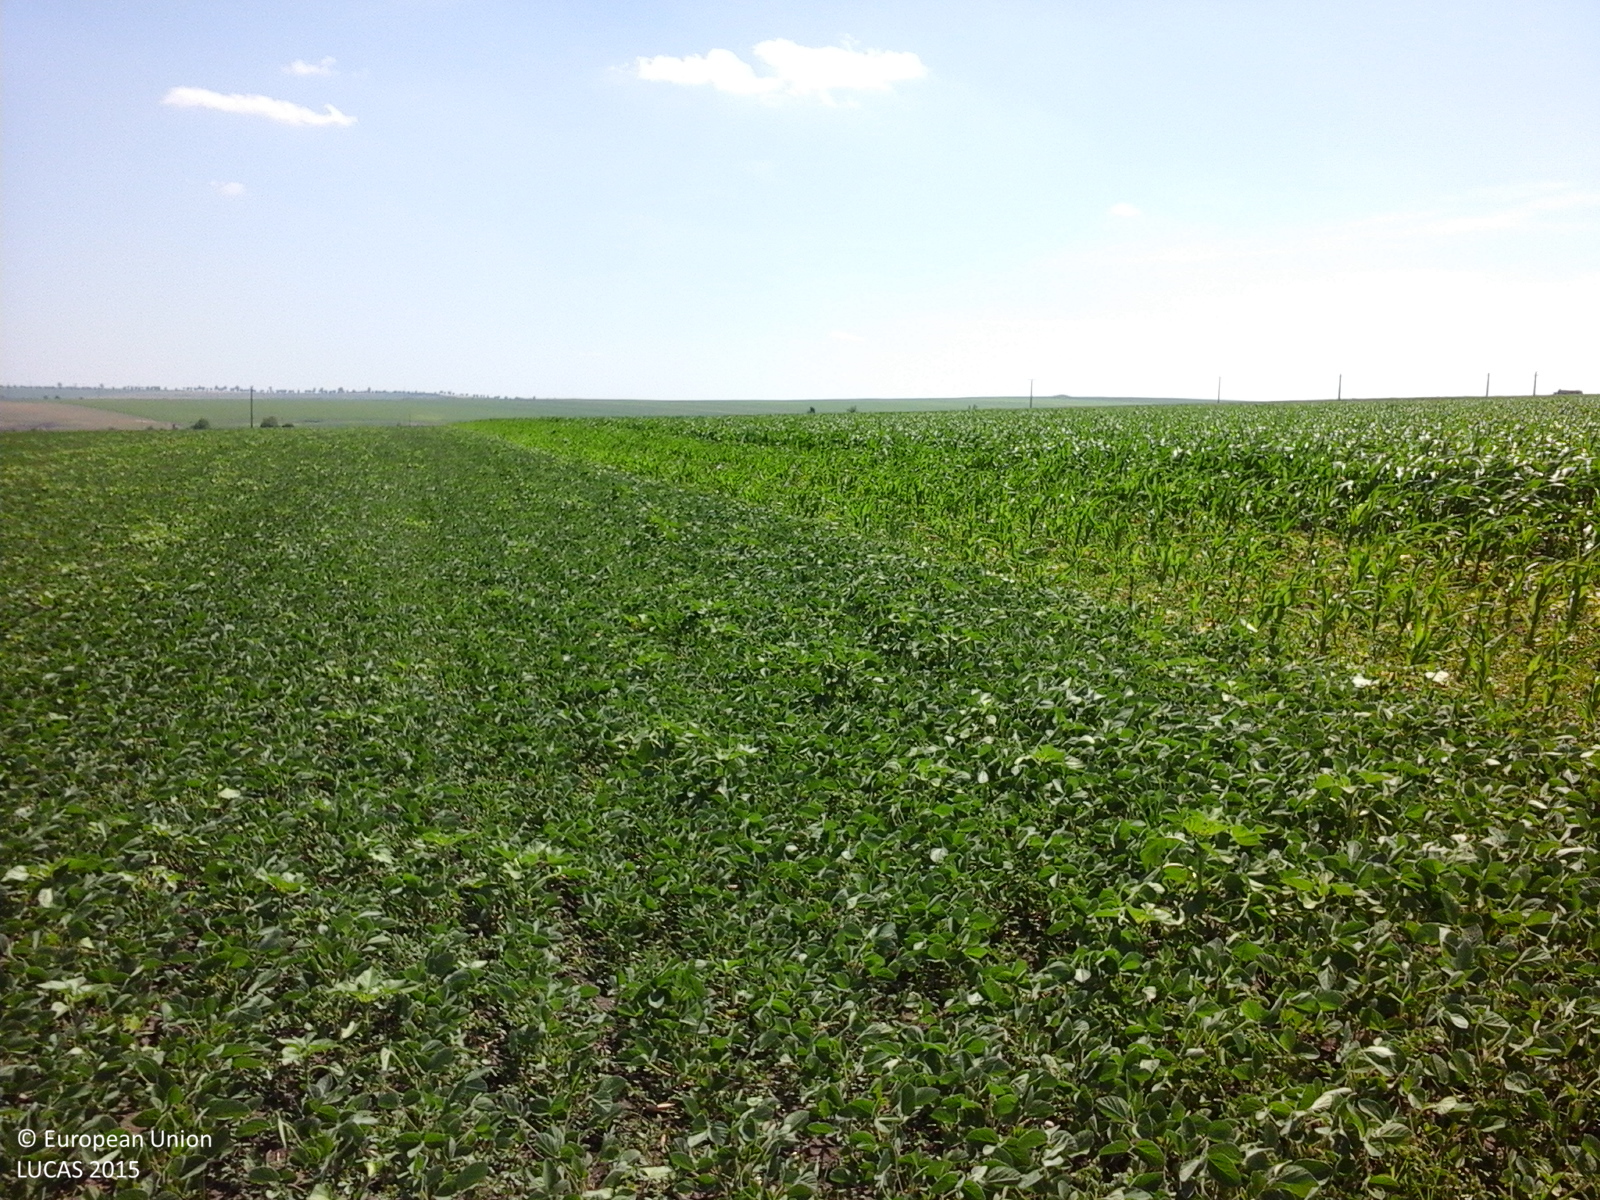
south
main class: Cropland
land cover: Soya
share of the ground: > 75 %
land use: Agriculture (excluding fallow land and kitchen gardens)
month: June
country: RO
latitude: 47.9545
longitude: 27.1298
